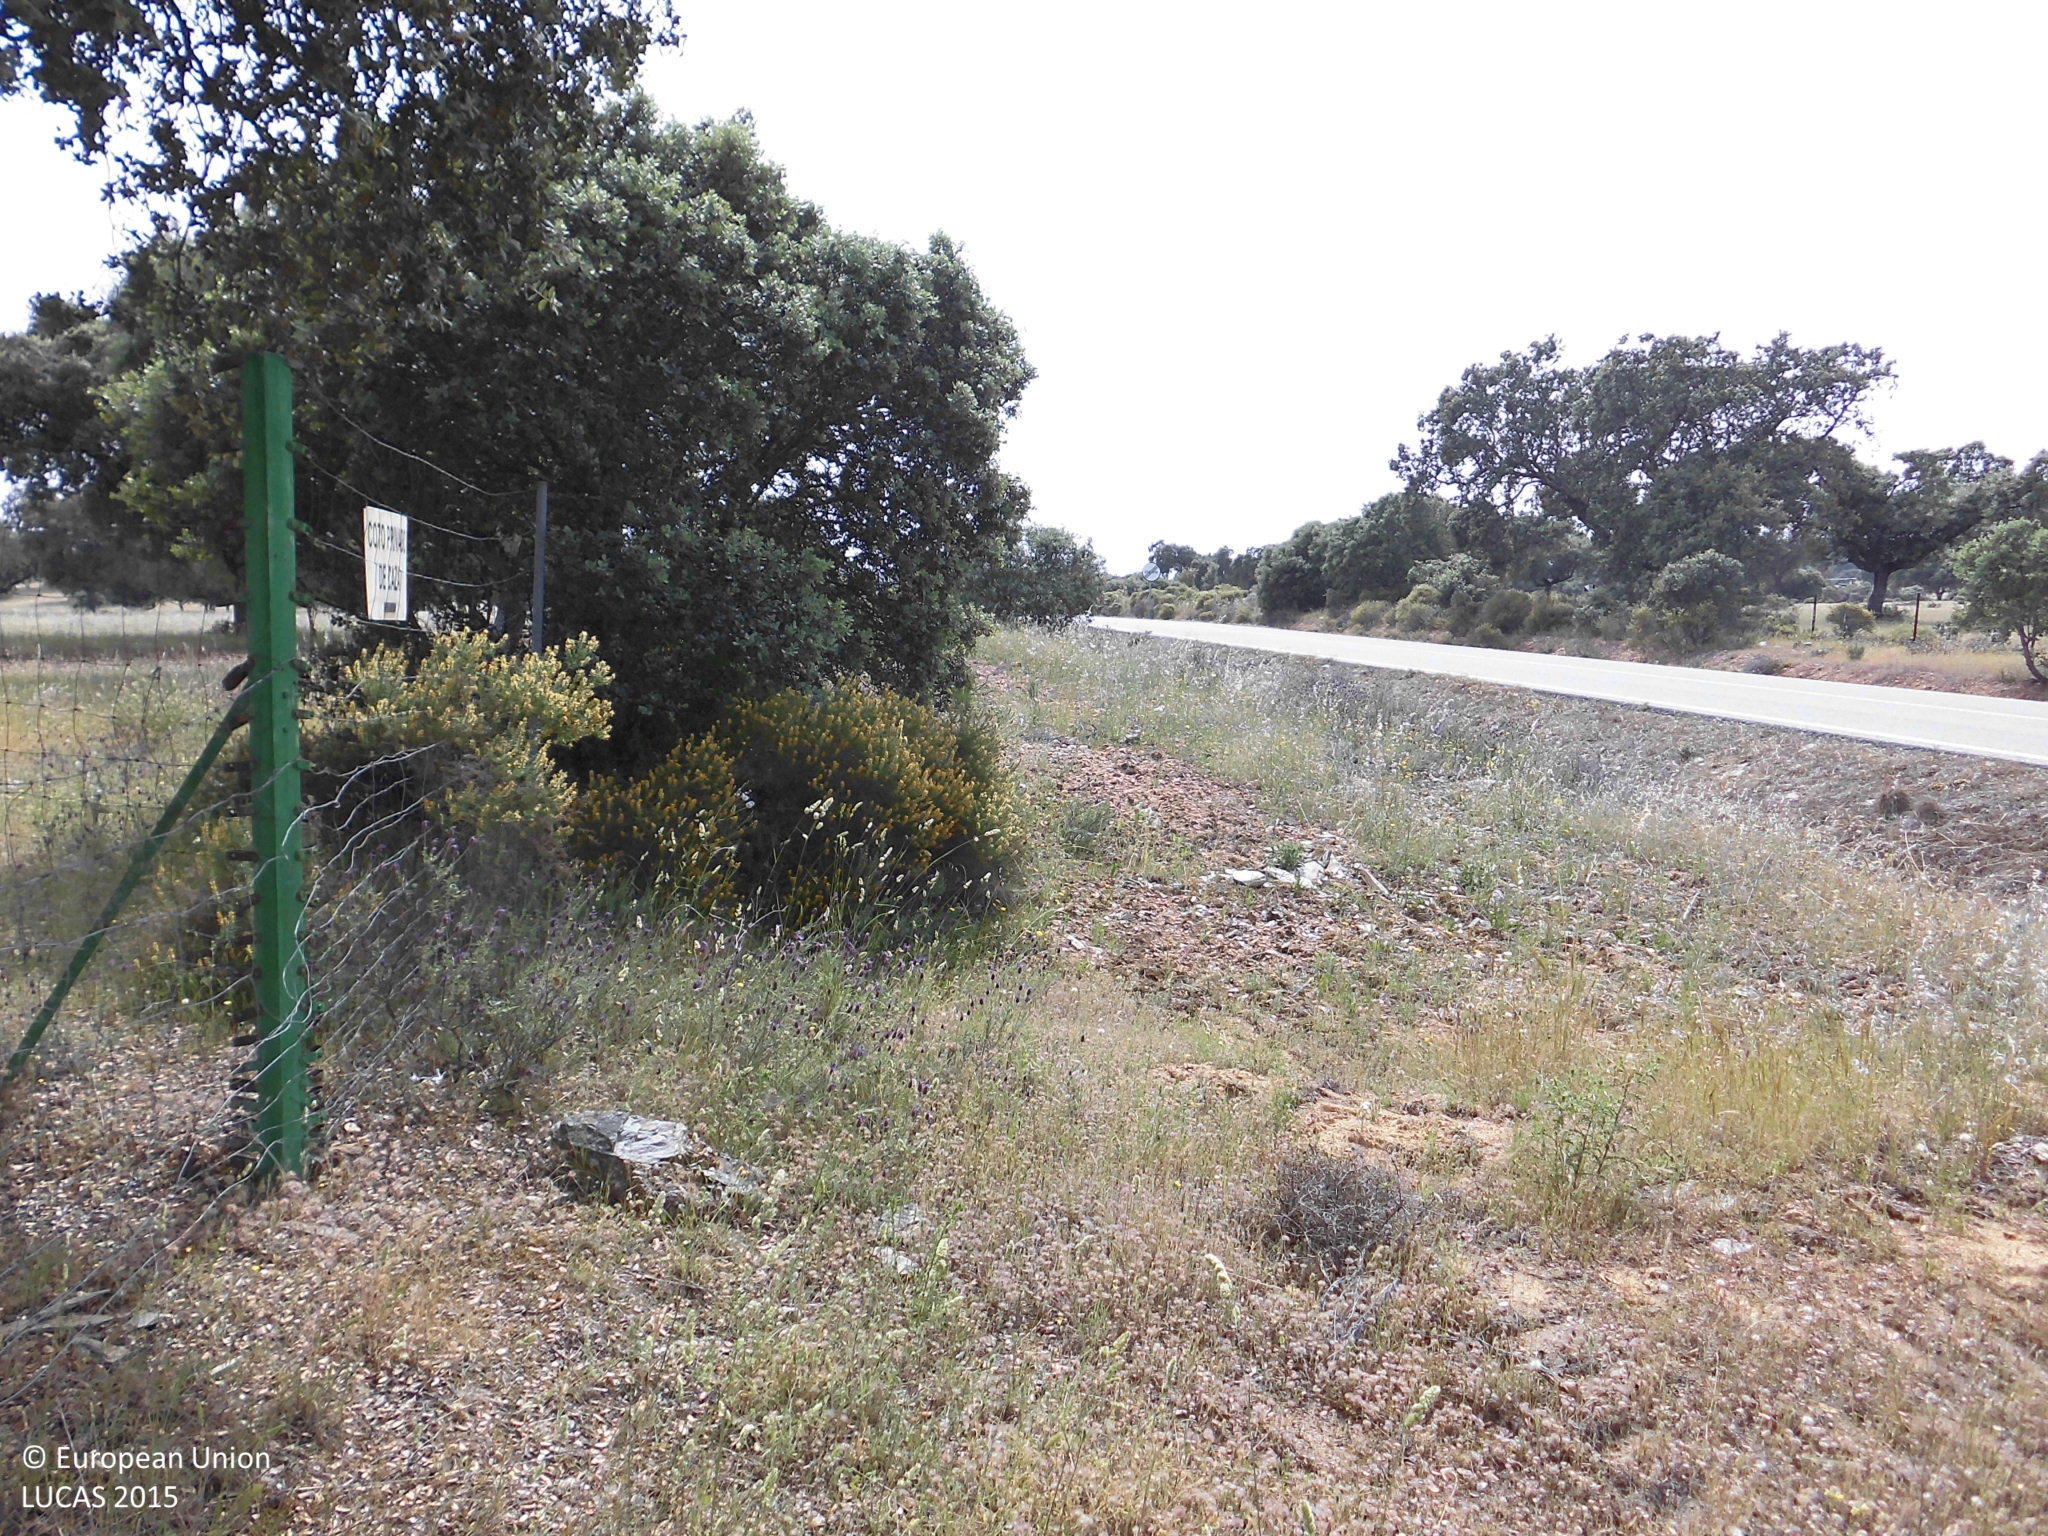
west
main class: Woodland
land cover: Broadleaved woodland
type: broadleaved evergreen forest
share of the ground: 10 - 25 %
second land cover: Grassland without tree/shrub cover
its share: > 75 %
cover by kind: herbaceous plants 90 %, broadleaved forest trees 10 %
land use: Forestry
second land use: Agriculture (excluding fallow land and kitchen gardens)
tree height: > 5 m
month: May
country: ES
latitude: 39.7182
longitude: -6.1068
